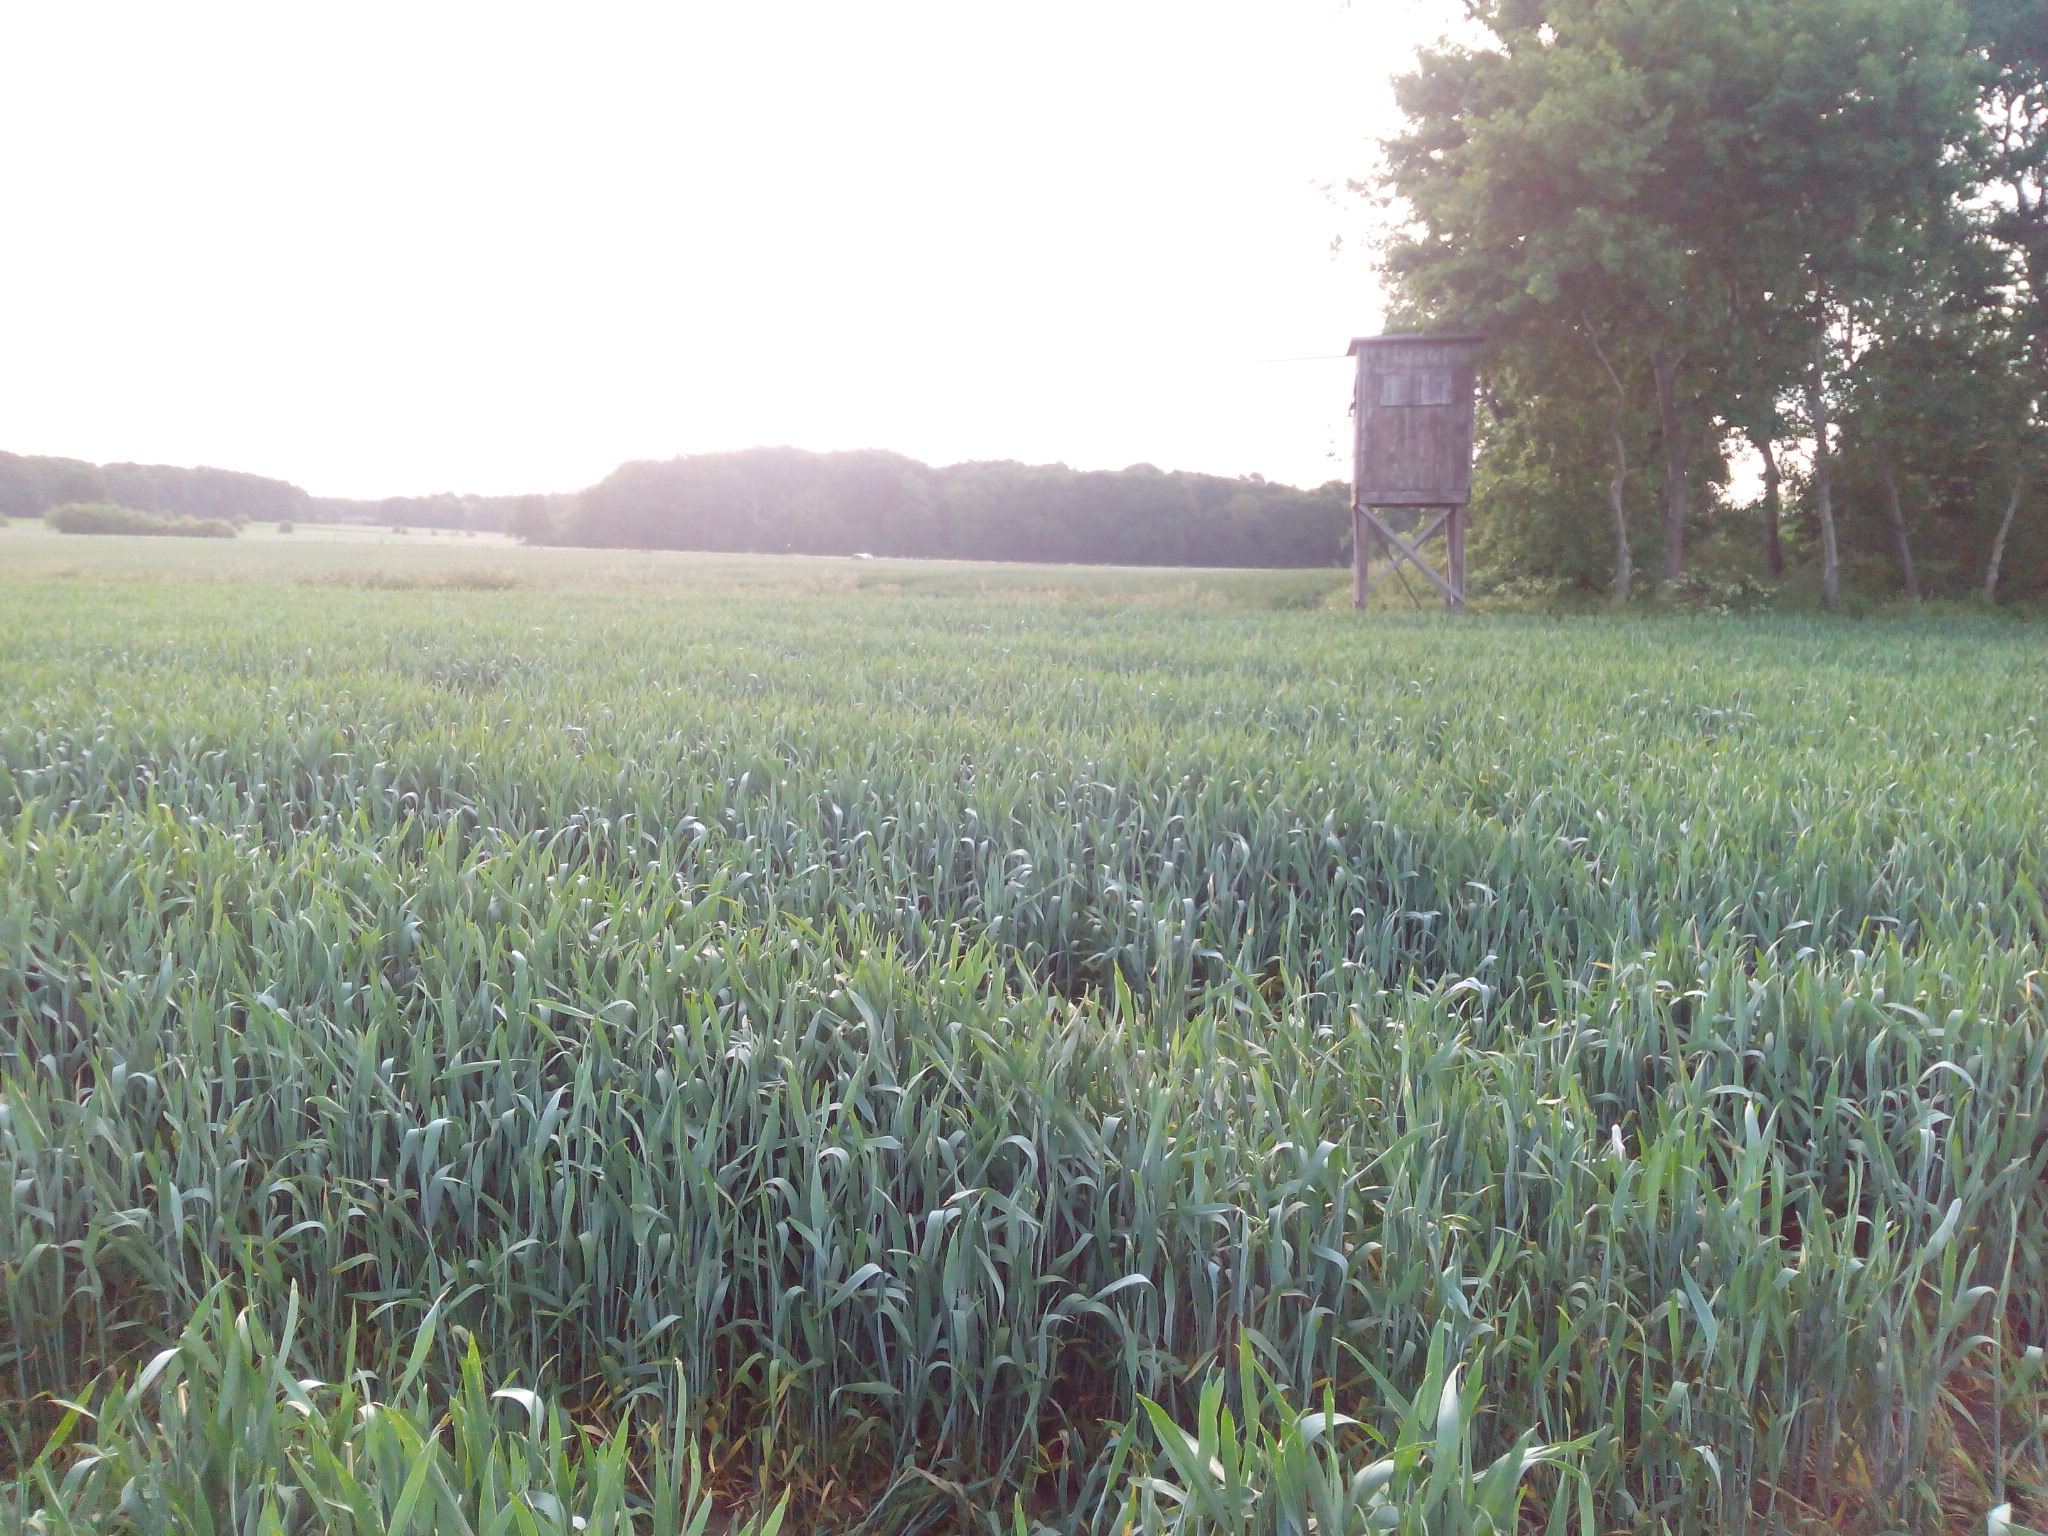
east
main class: Cropland
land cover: Common wheat
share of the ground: > 75 %
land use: Agriculture (excluding fallow land and kitchen gardens)
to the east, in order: Common wheat; Grass margins; Ditches and canals; Grass margins; Common wheat; Grass margins; Fences; Grassland without tree/shrub cover; Fences; Grassland without tree/shrub cover
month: June
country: DE
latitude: 52.3589
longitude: 9.6330
